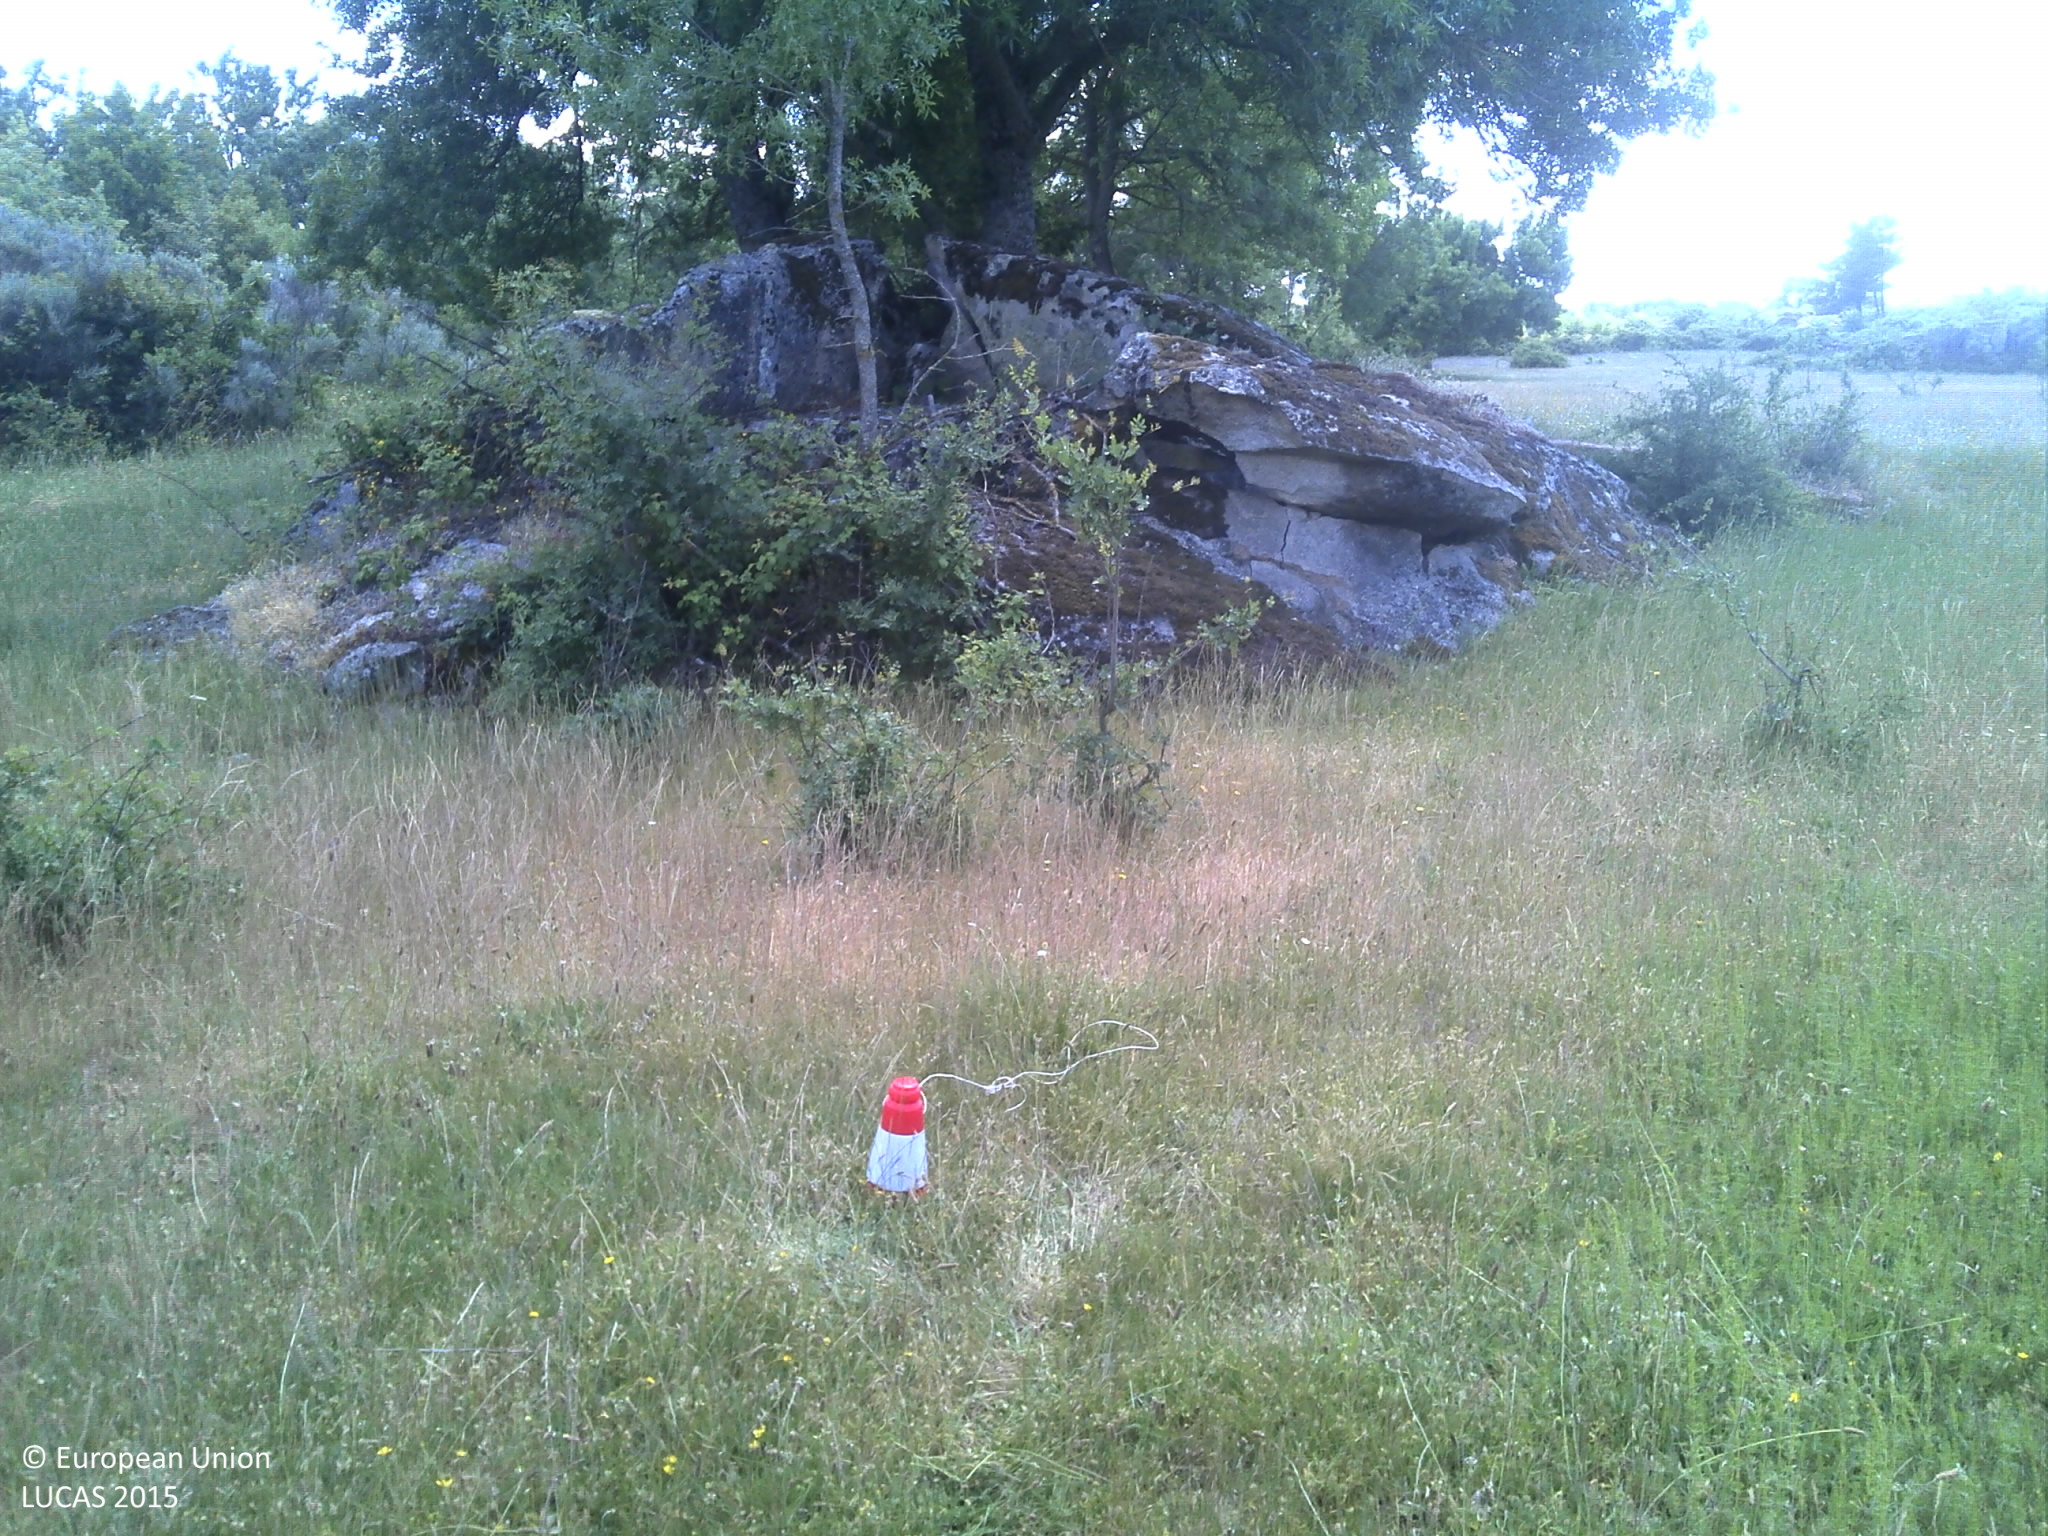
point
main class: Grassland
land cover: Grassland with sparse tree/shrub cover
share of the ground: 50 - 75 %
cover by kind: herbaceous plants 70 %, consolidated bare surface 10 %, broadleaved forest trees 5 %, shrubs 5 %
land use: Agriculture (excluding fallow land and kitchen gardens)
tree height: > 5 m
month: May
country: PT
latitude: 40.7016
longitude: -7.1363
